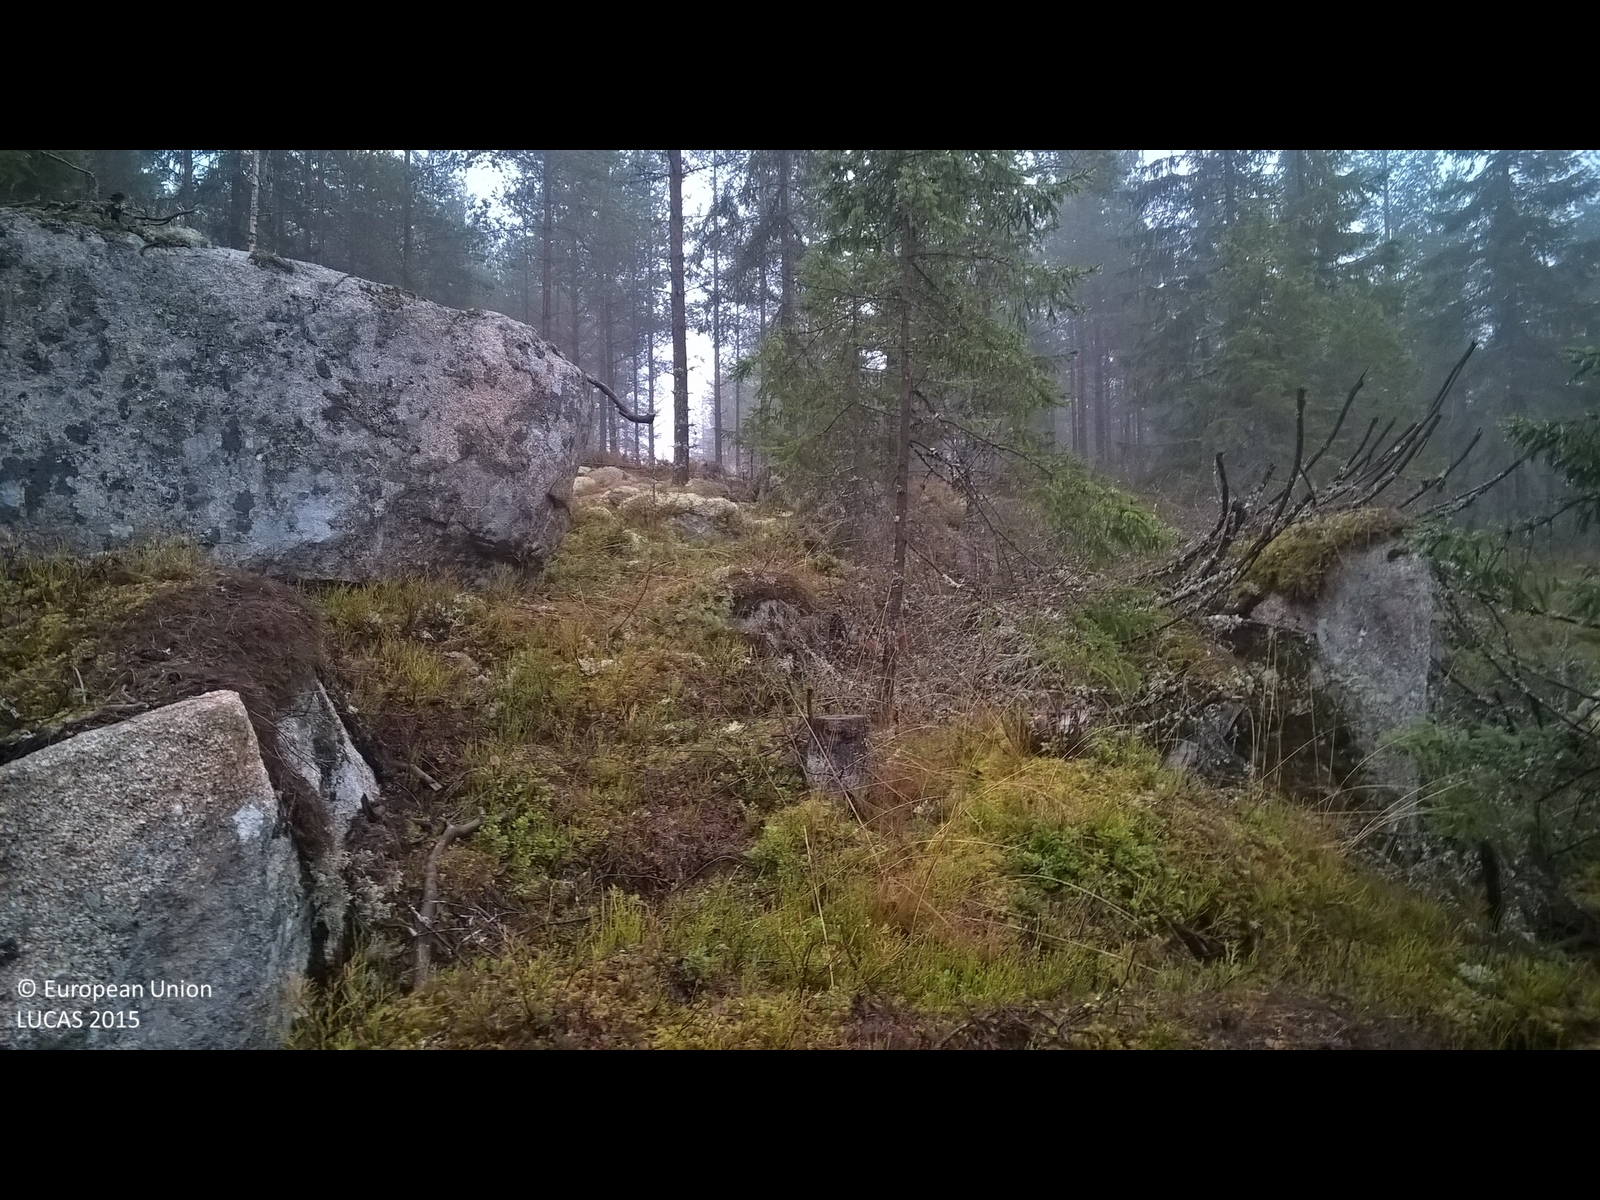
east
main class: Grassland
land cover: Grassland with sparse tree/shrub cover
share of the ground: > 75 %
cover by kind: lichens and mosses 55 %, herbaceous plants 30 %, shrubs 10 %, coniferous forest trees 5 %
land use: Forestry
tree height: > 5 m
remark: Clear cut
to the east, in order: Grassland with sparse tree/shrub cover; Tracks; Pine dominated coniferous woodland; Paved roads, cycling and walking lanes; Pine dominated coniferous woodland; Paved roads, cycling and walking lanes
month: November
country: SE
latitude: 60.0908
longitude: 14.5022
